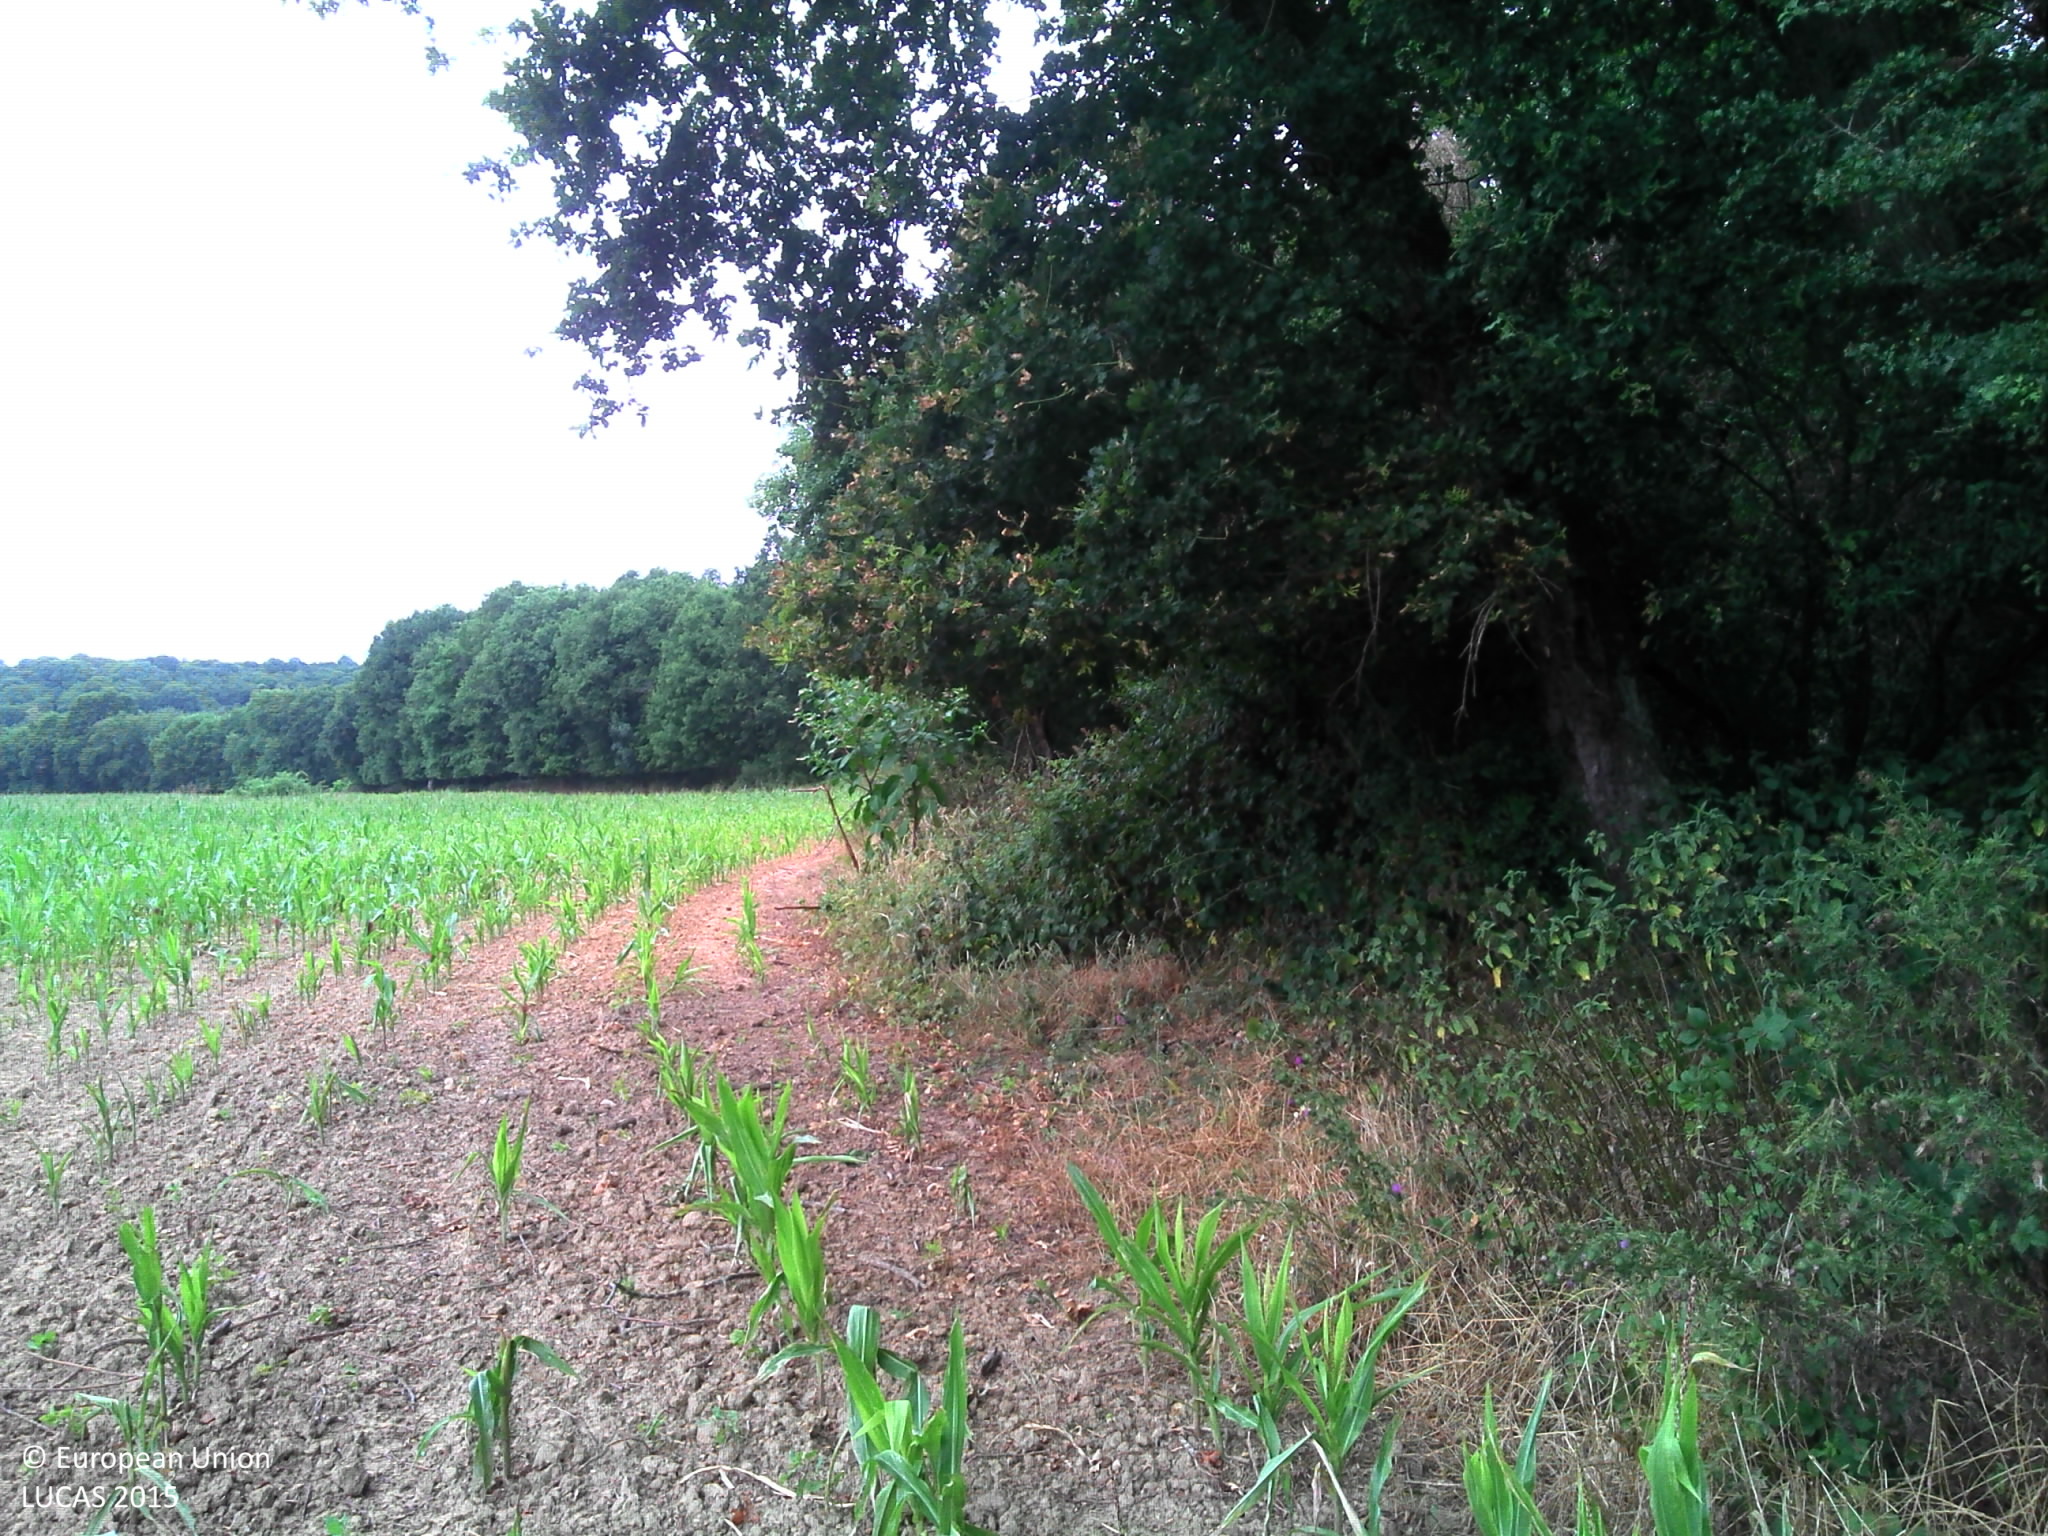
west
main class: Cropland
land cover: Maize
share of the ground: 10 - 25 %
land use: Agriculture (excluding fallow land and kitchen gardens)
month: July
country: FR
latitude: 48.4387
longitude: 2.5144
